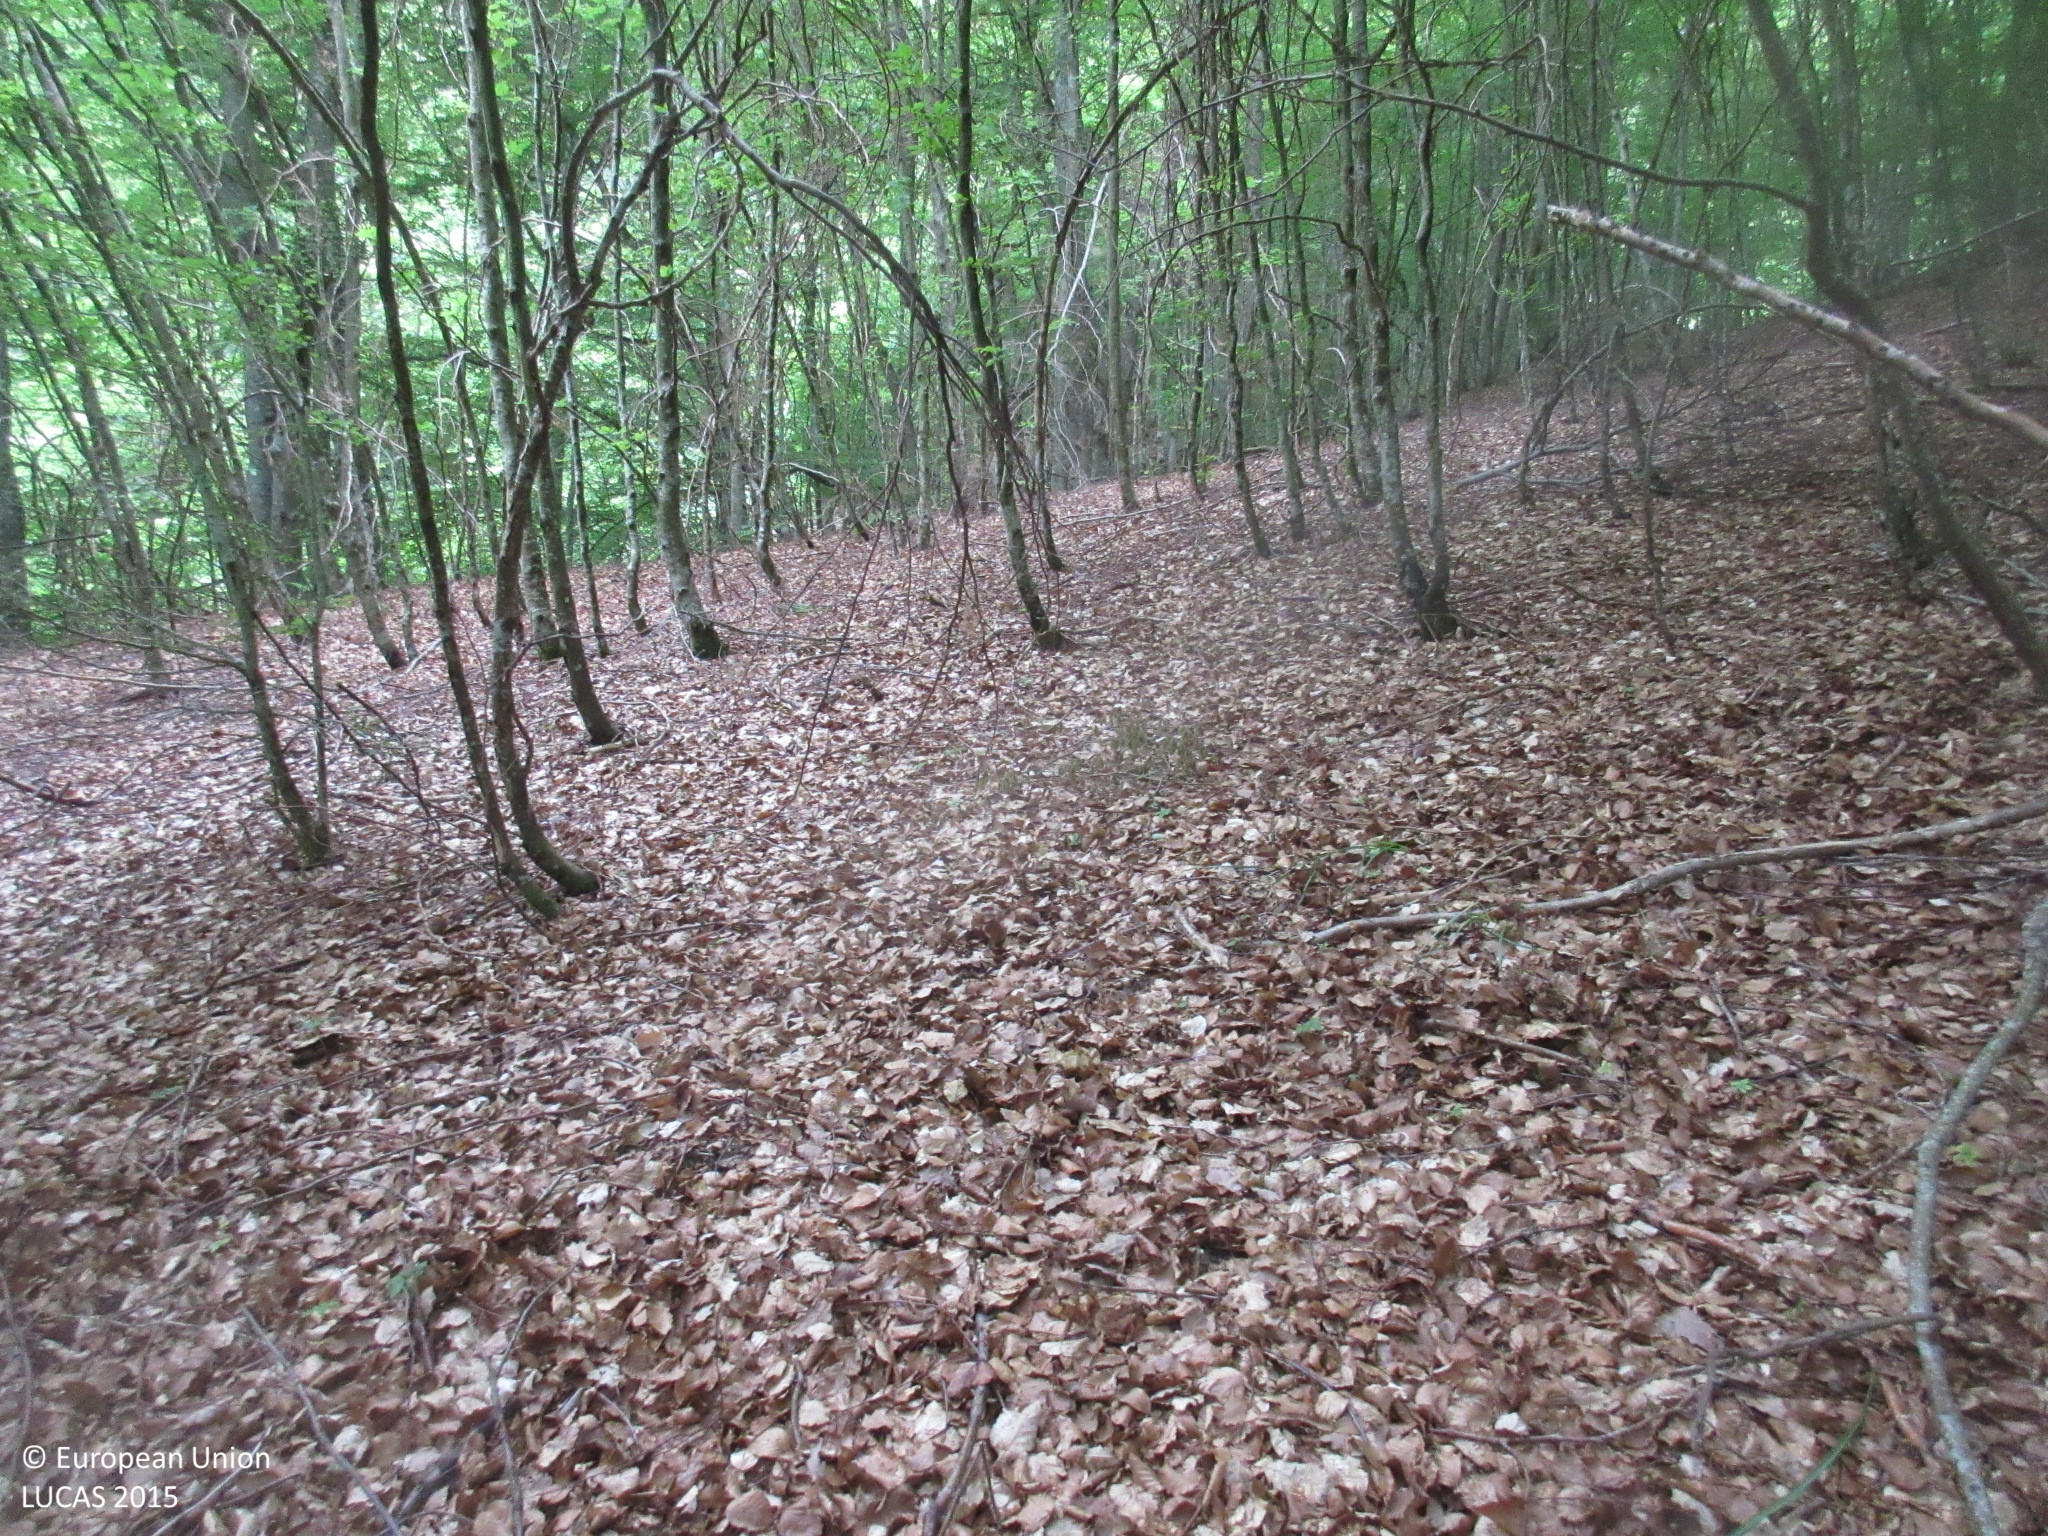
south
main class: Woodland
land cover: Broadleaved woodland
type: beech forest
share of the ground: > 75 %
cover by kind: broadleaved forest trees 100 %
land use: Semi-natural and natural areas not in use
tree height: > 5 m
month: June
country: ES
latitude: 43.0678
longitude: -4.5112
